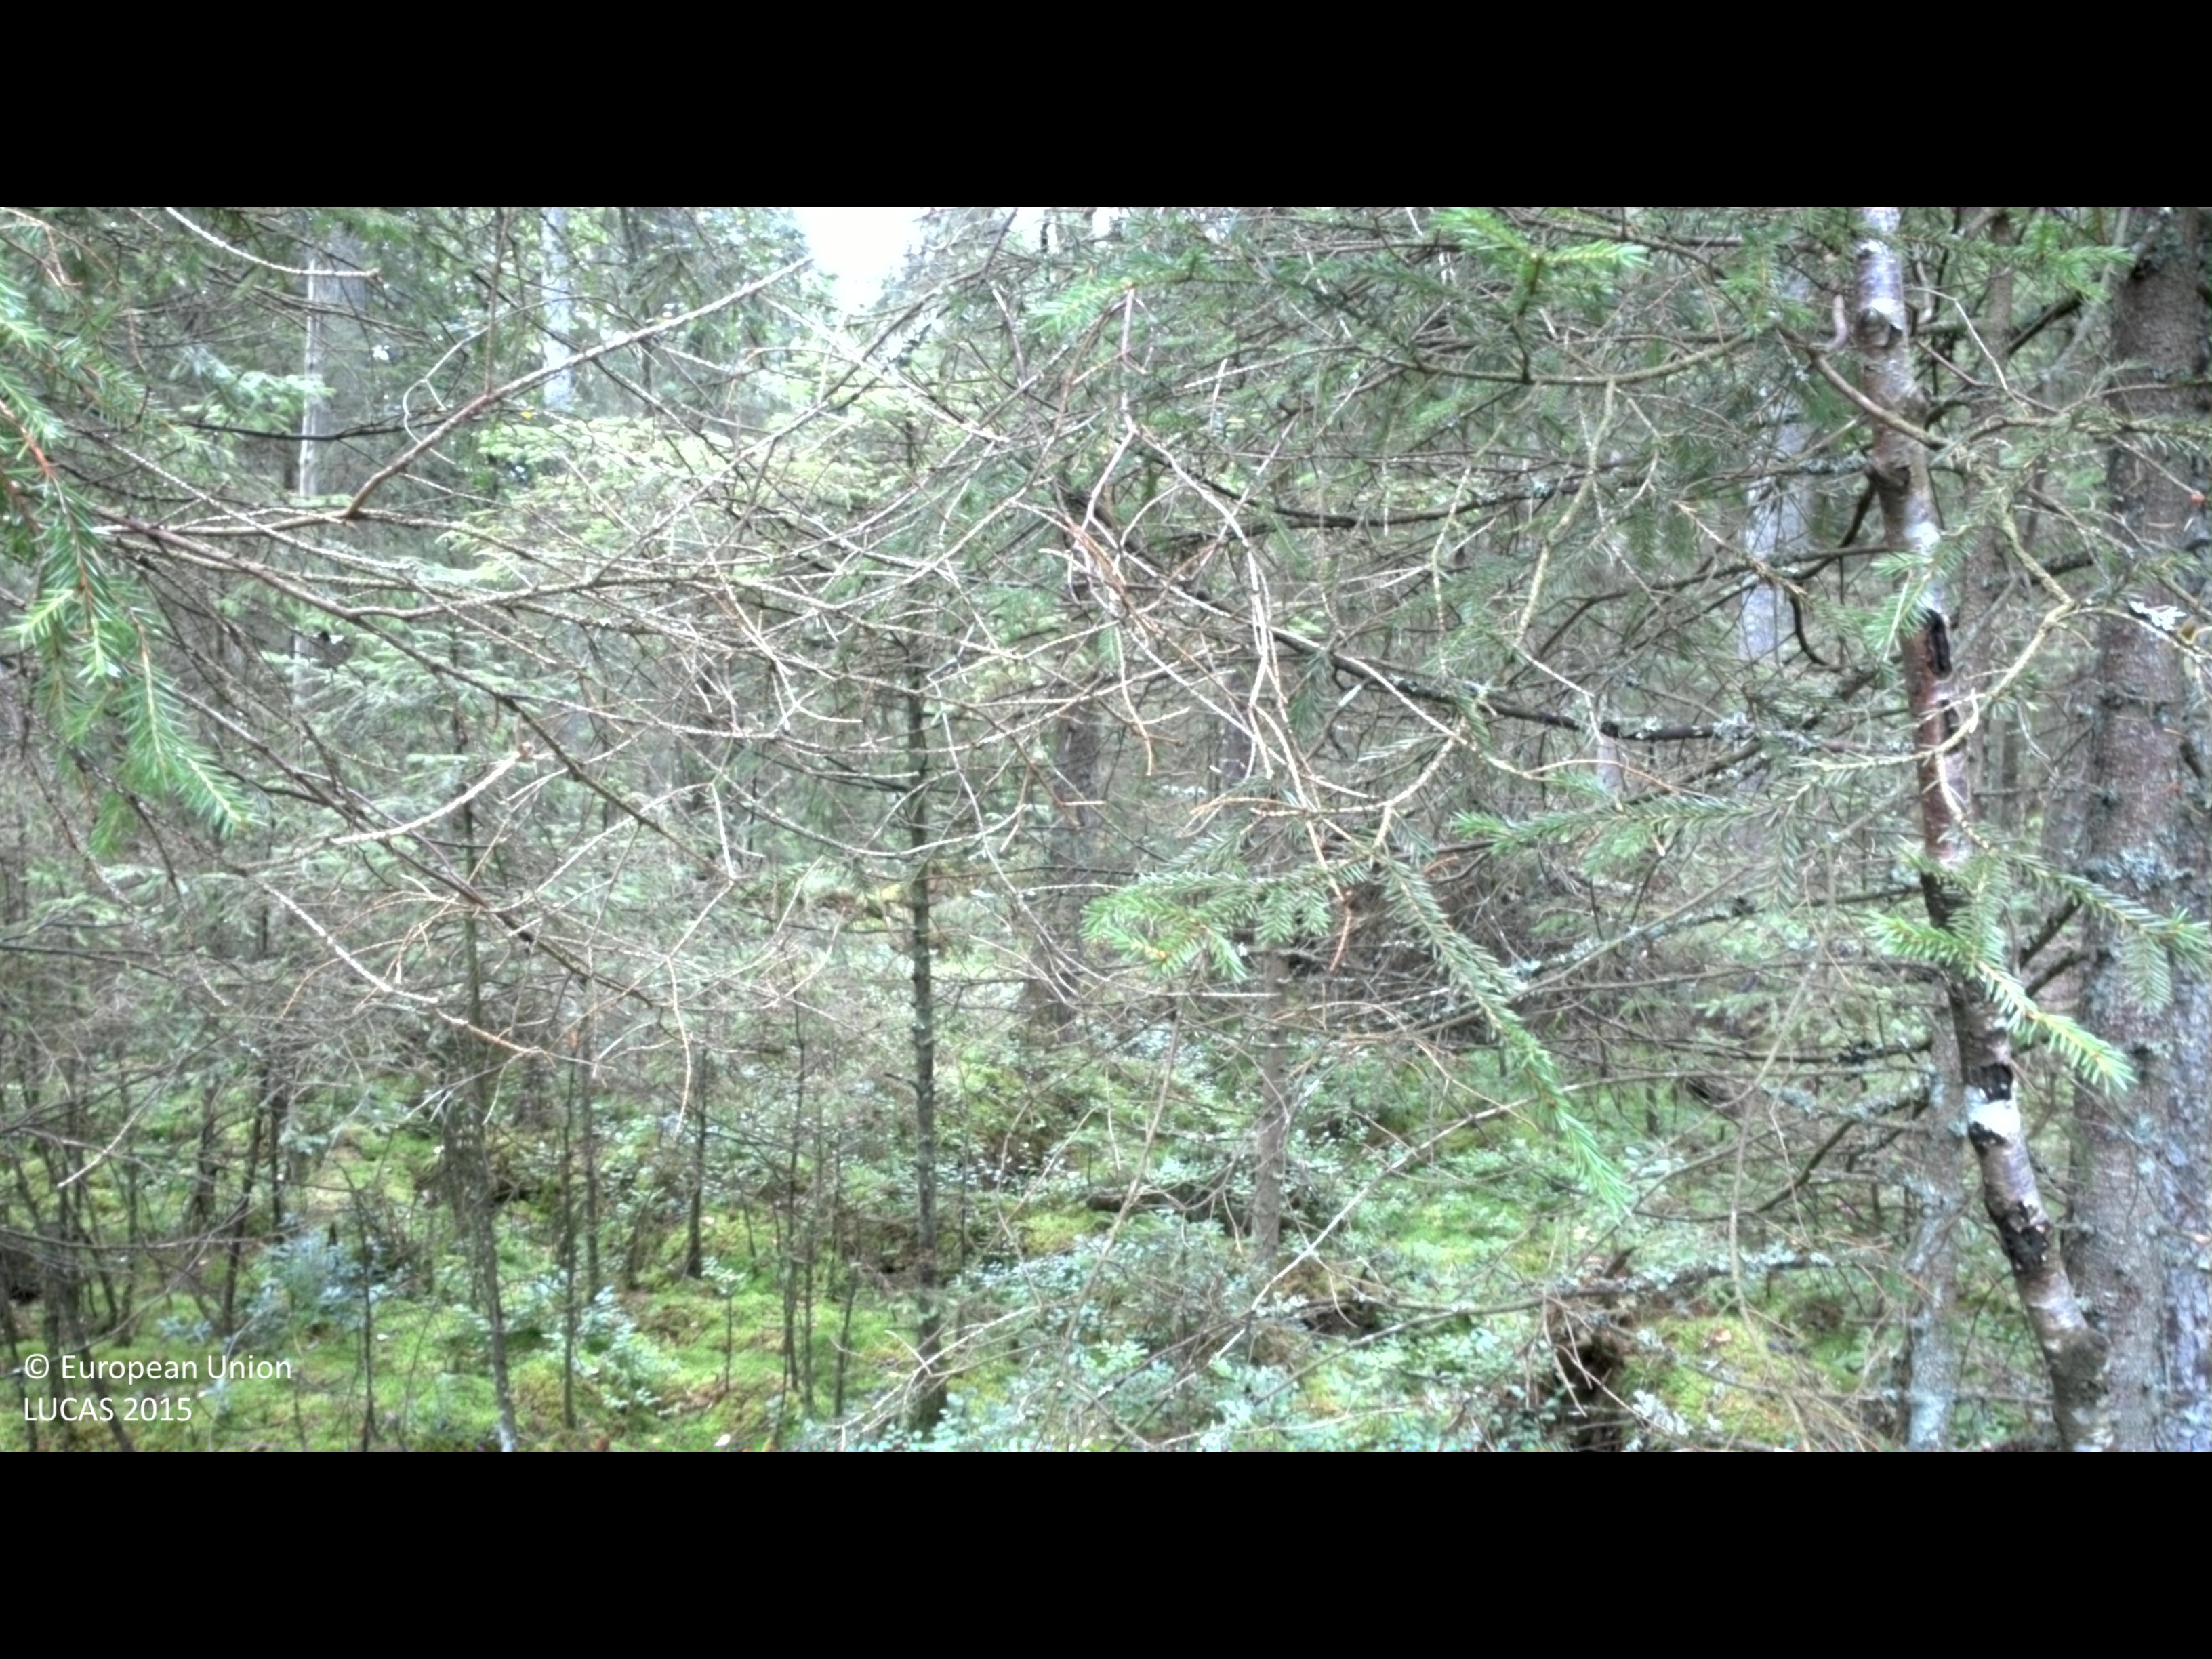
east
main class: Woodland
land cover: Spruce dominated coniferous woodland
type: boreal forest
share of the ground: 50 - 75 %
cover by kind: coniferous forest trees 60 %, shrubs 30 %, broadleaved forest trees 5 %, lichens and mosses 5 %
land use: Forestry
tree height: > 5 m
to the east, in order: Spruce dominated coniferous woodland; Spruce dominated mixed woodland; Ditches and canals; Pine dominated coniferous woodland; Ditches and canals; Other coniferous woodland
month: August
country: SE
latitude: 57.0465
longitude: 13.2435
